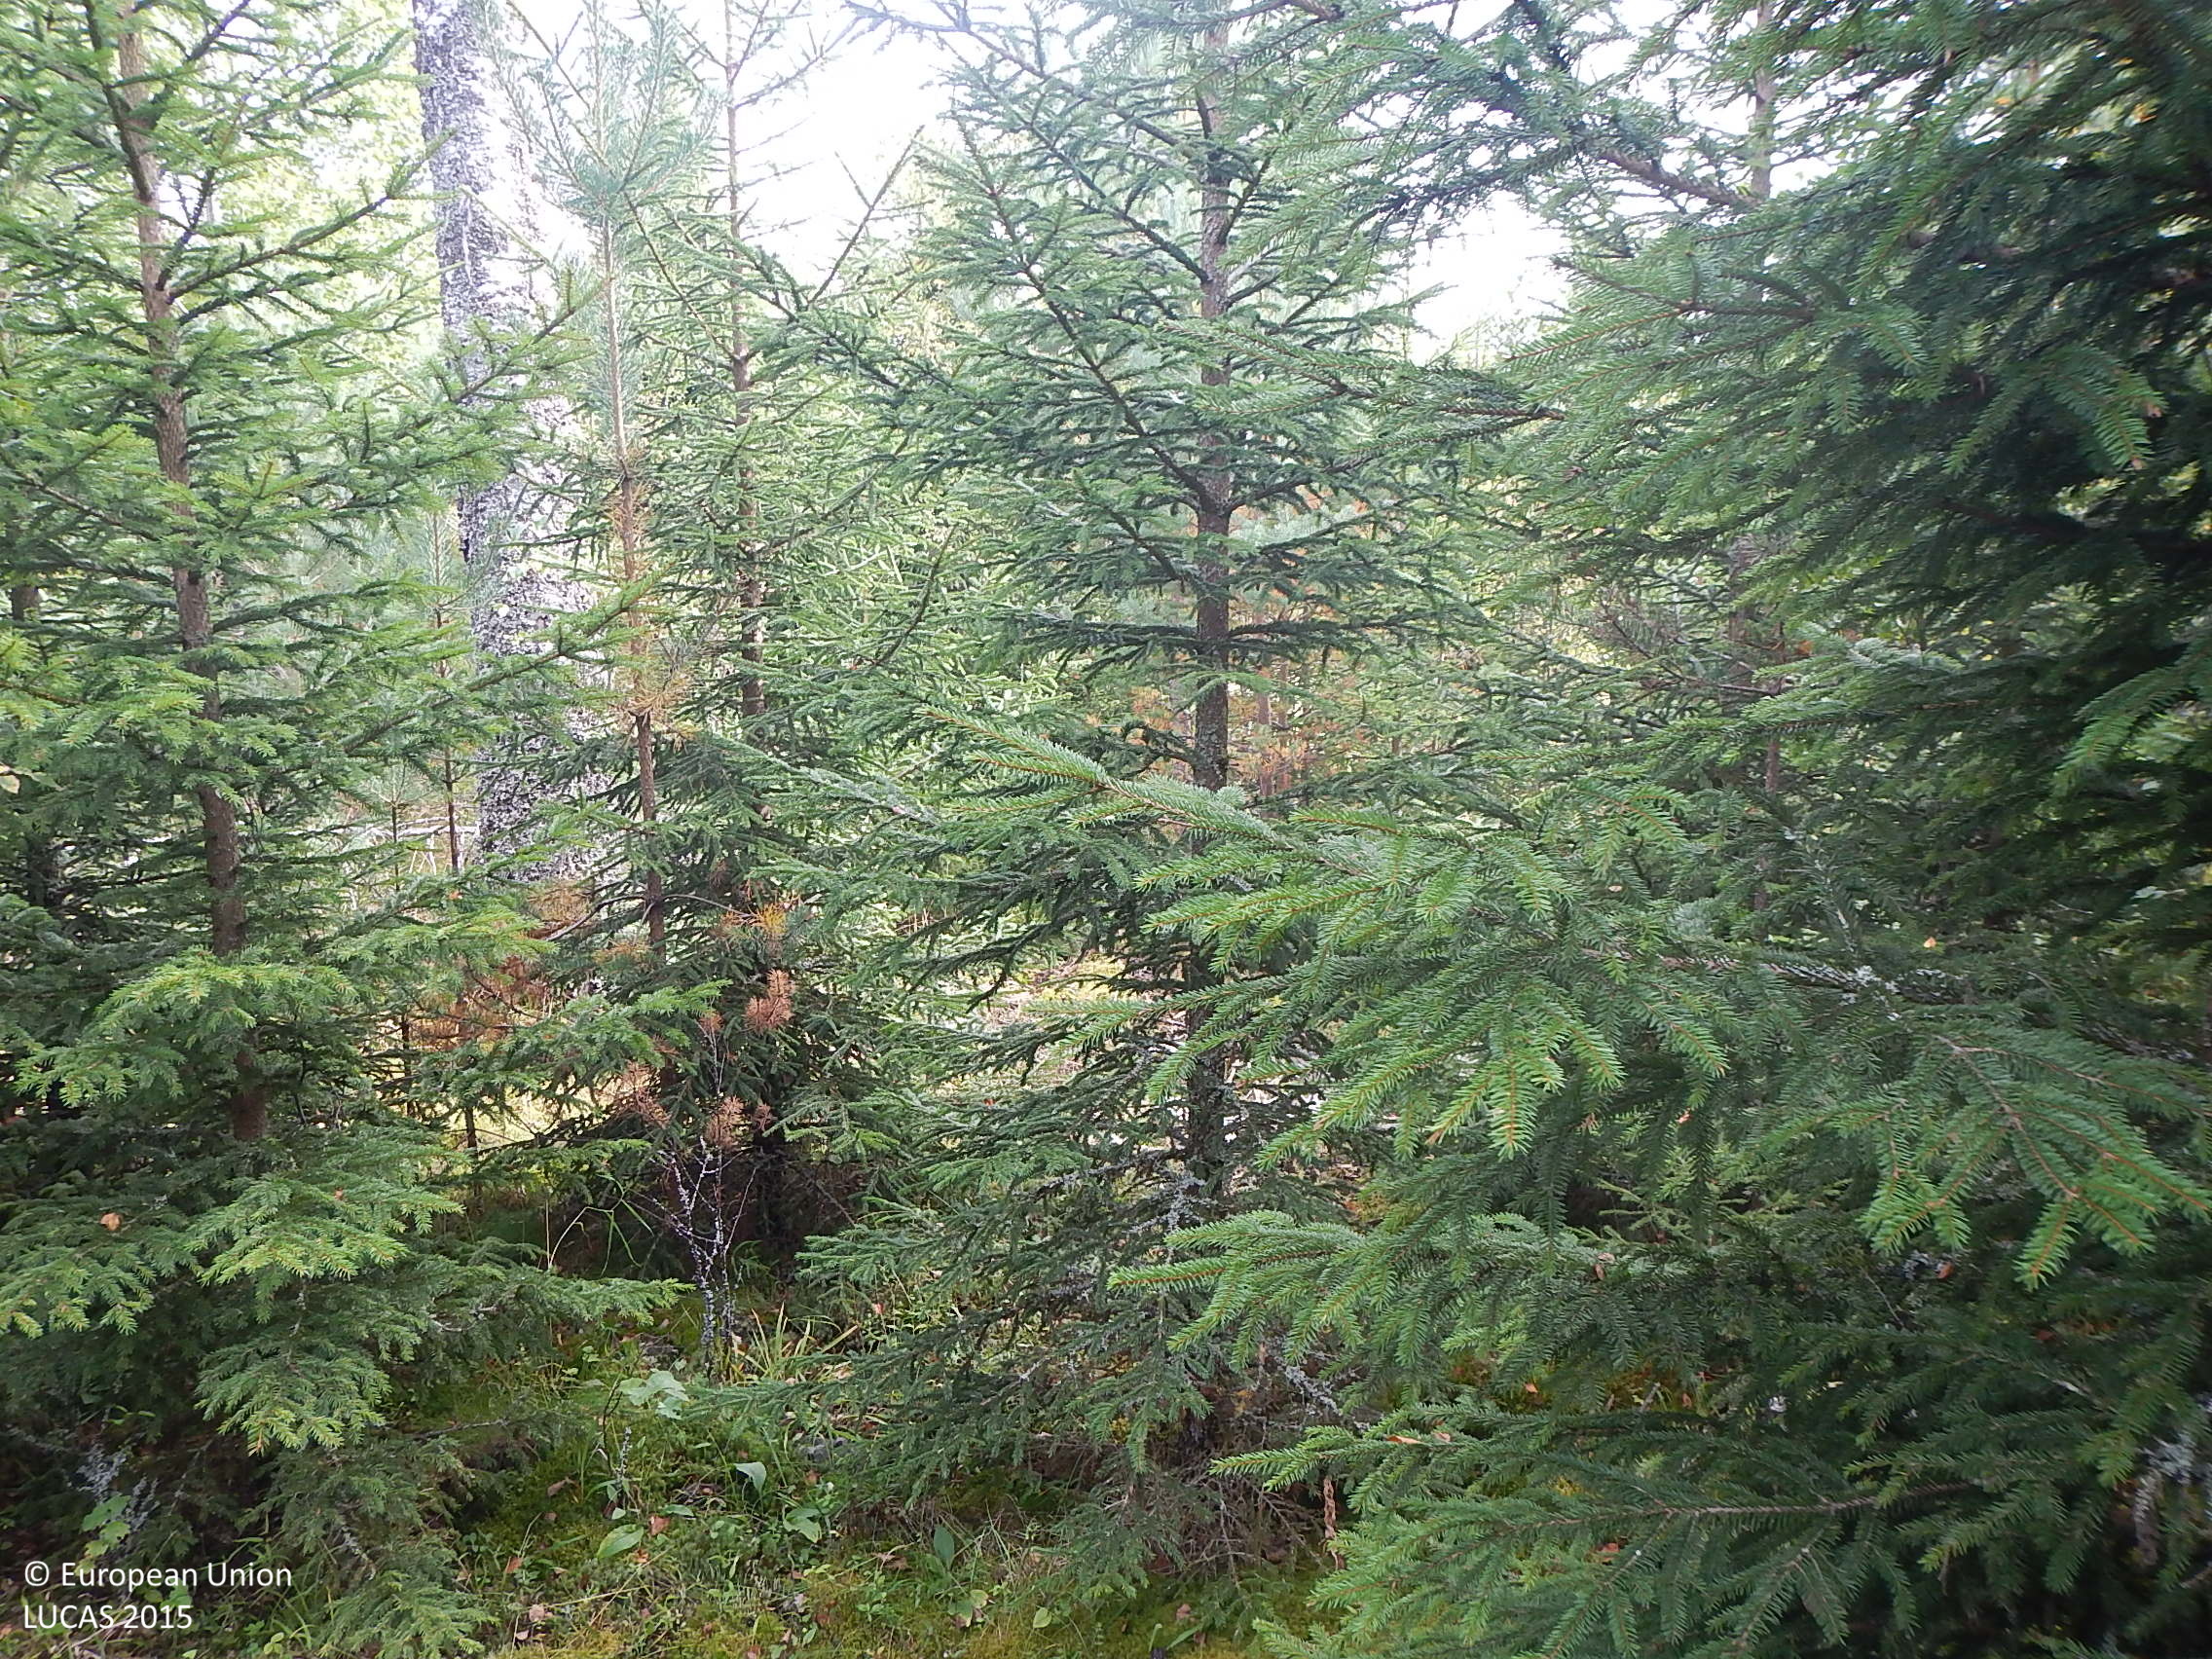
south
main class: Woodland
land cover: Other mixed woodland
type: boreal forest
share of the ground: > 75 %
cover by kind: coniferous forest trees 40 %, broadleaved forest trees 40 %, herbaceous plants 15 %, lichens and mosses 5 %
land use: Forestry
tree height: < 5 m
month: September
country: FI
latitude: 61.4507
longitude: 22.6901
